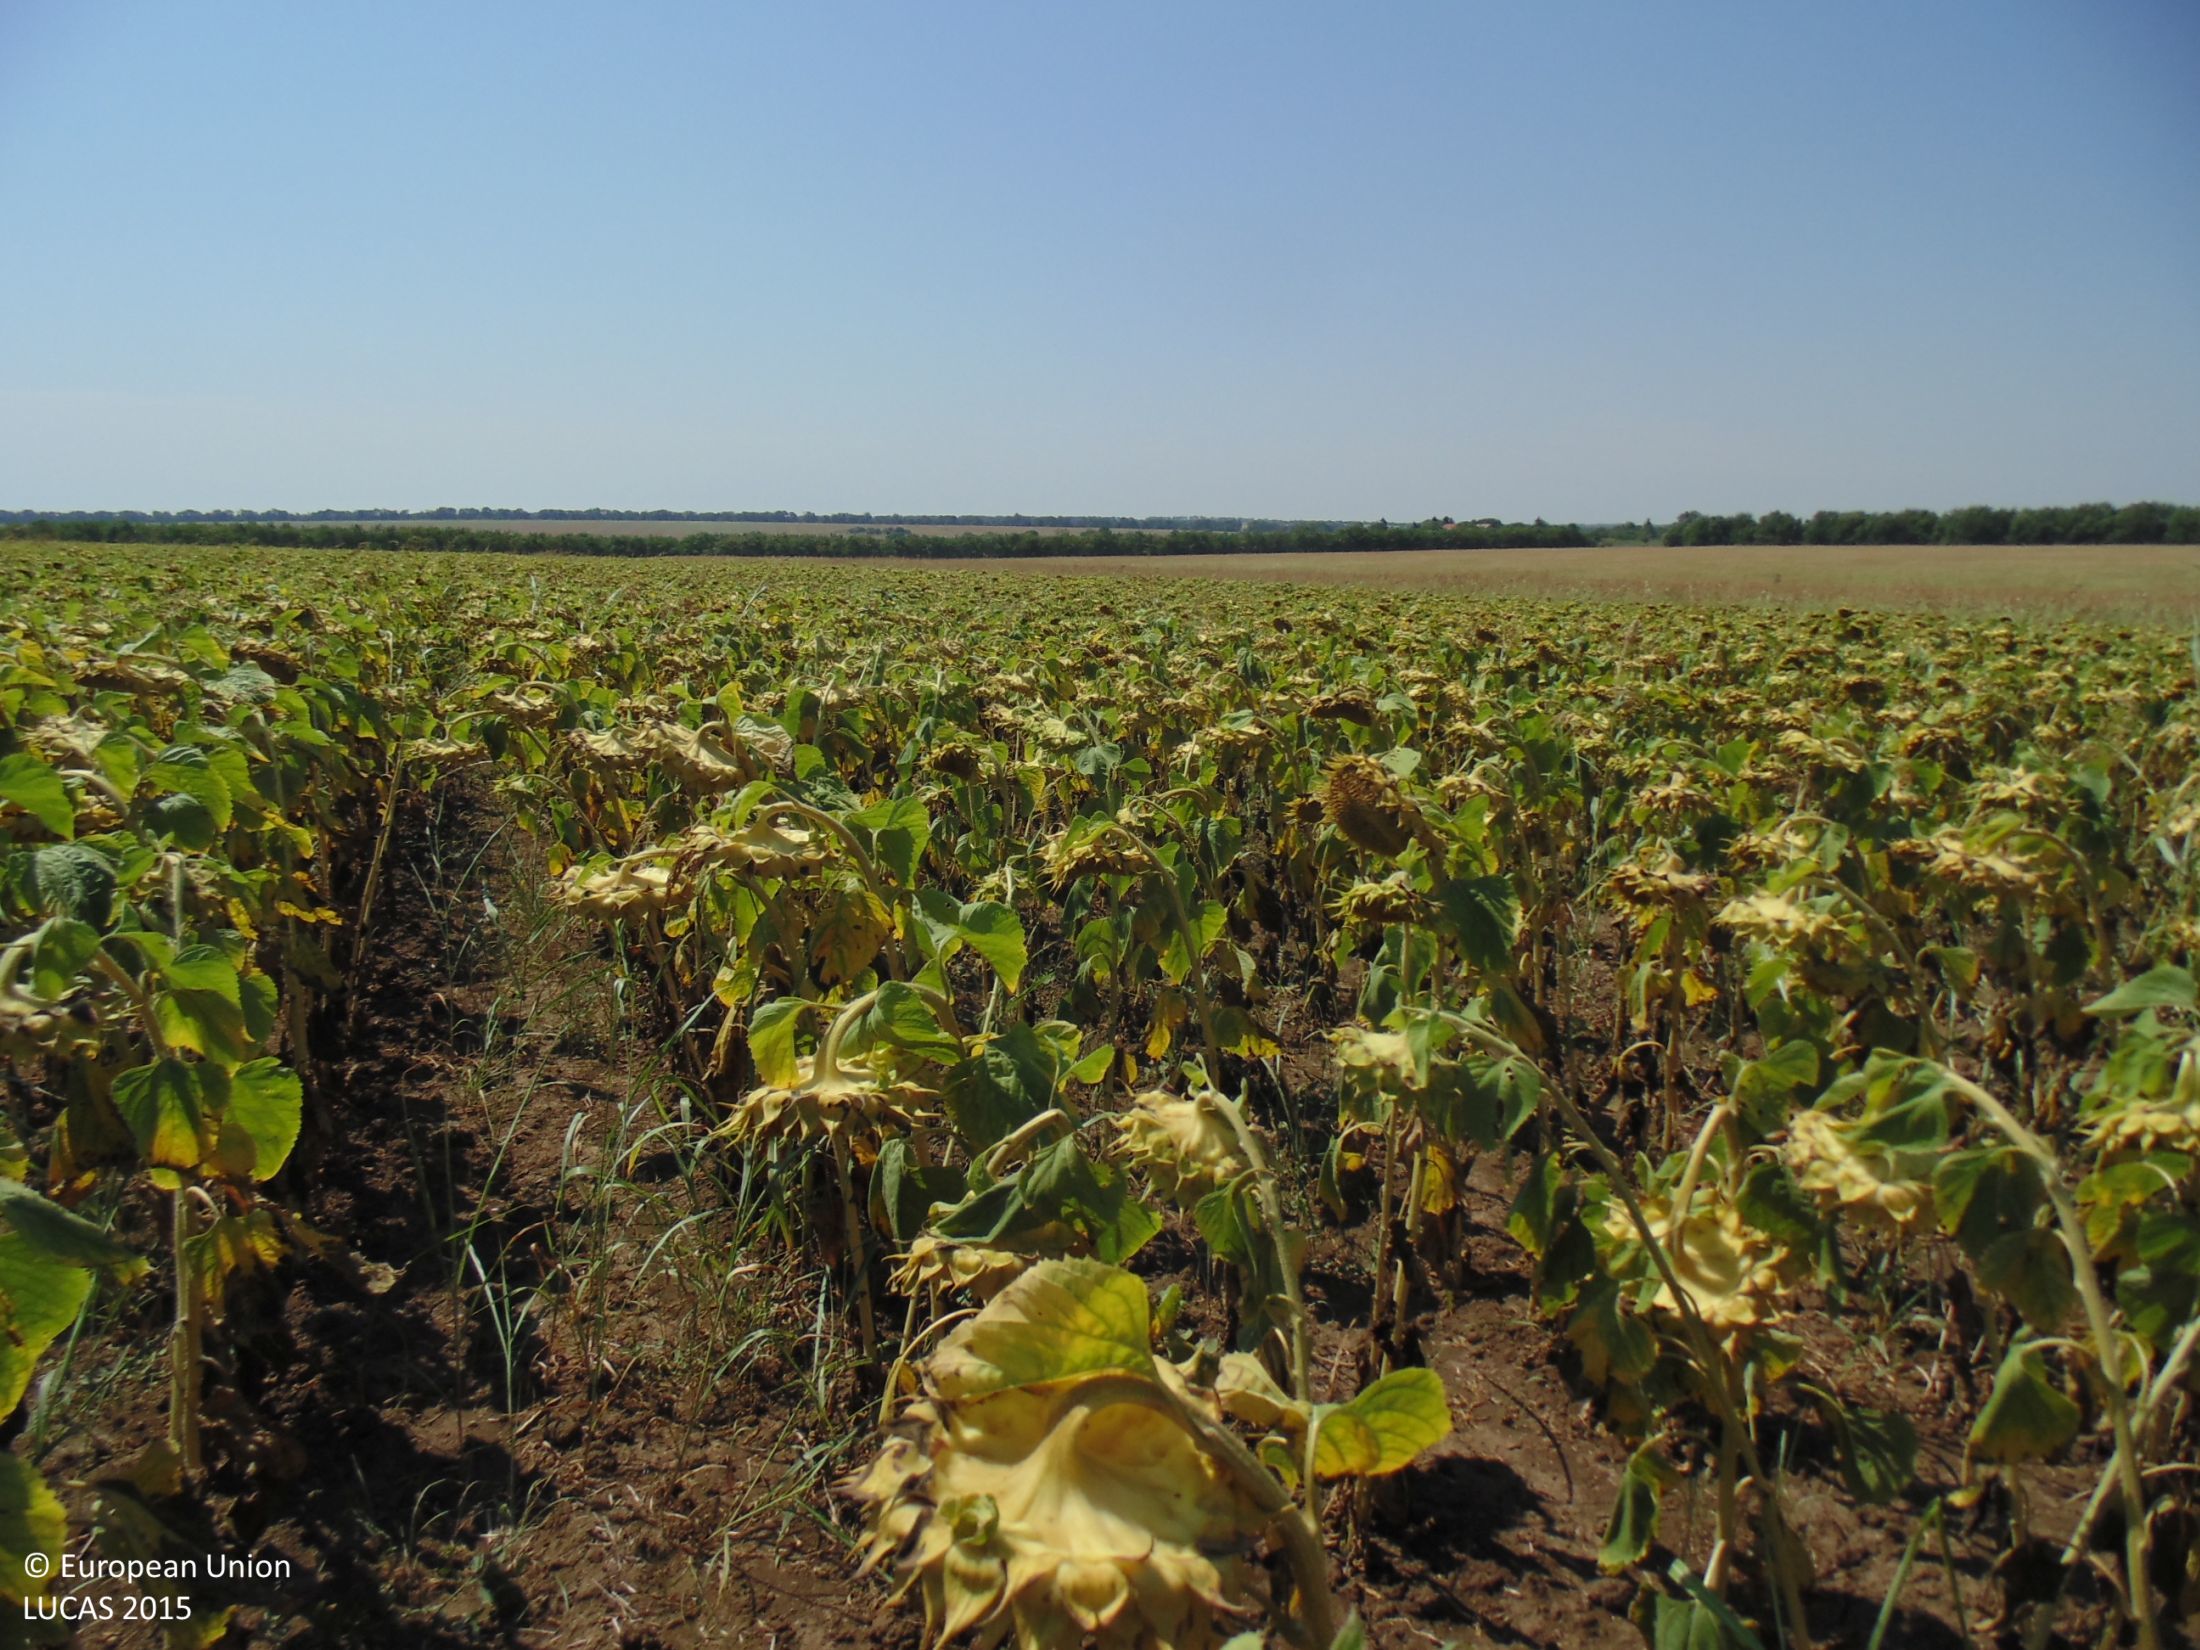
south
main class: Cropland
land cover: Sunflower
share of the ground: > 75 %
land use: Agriculture (excluding fallow land and kitchen gardens)
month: August
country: BG
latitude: 43.7313
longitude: 28.2446
